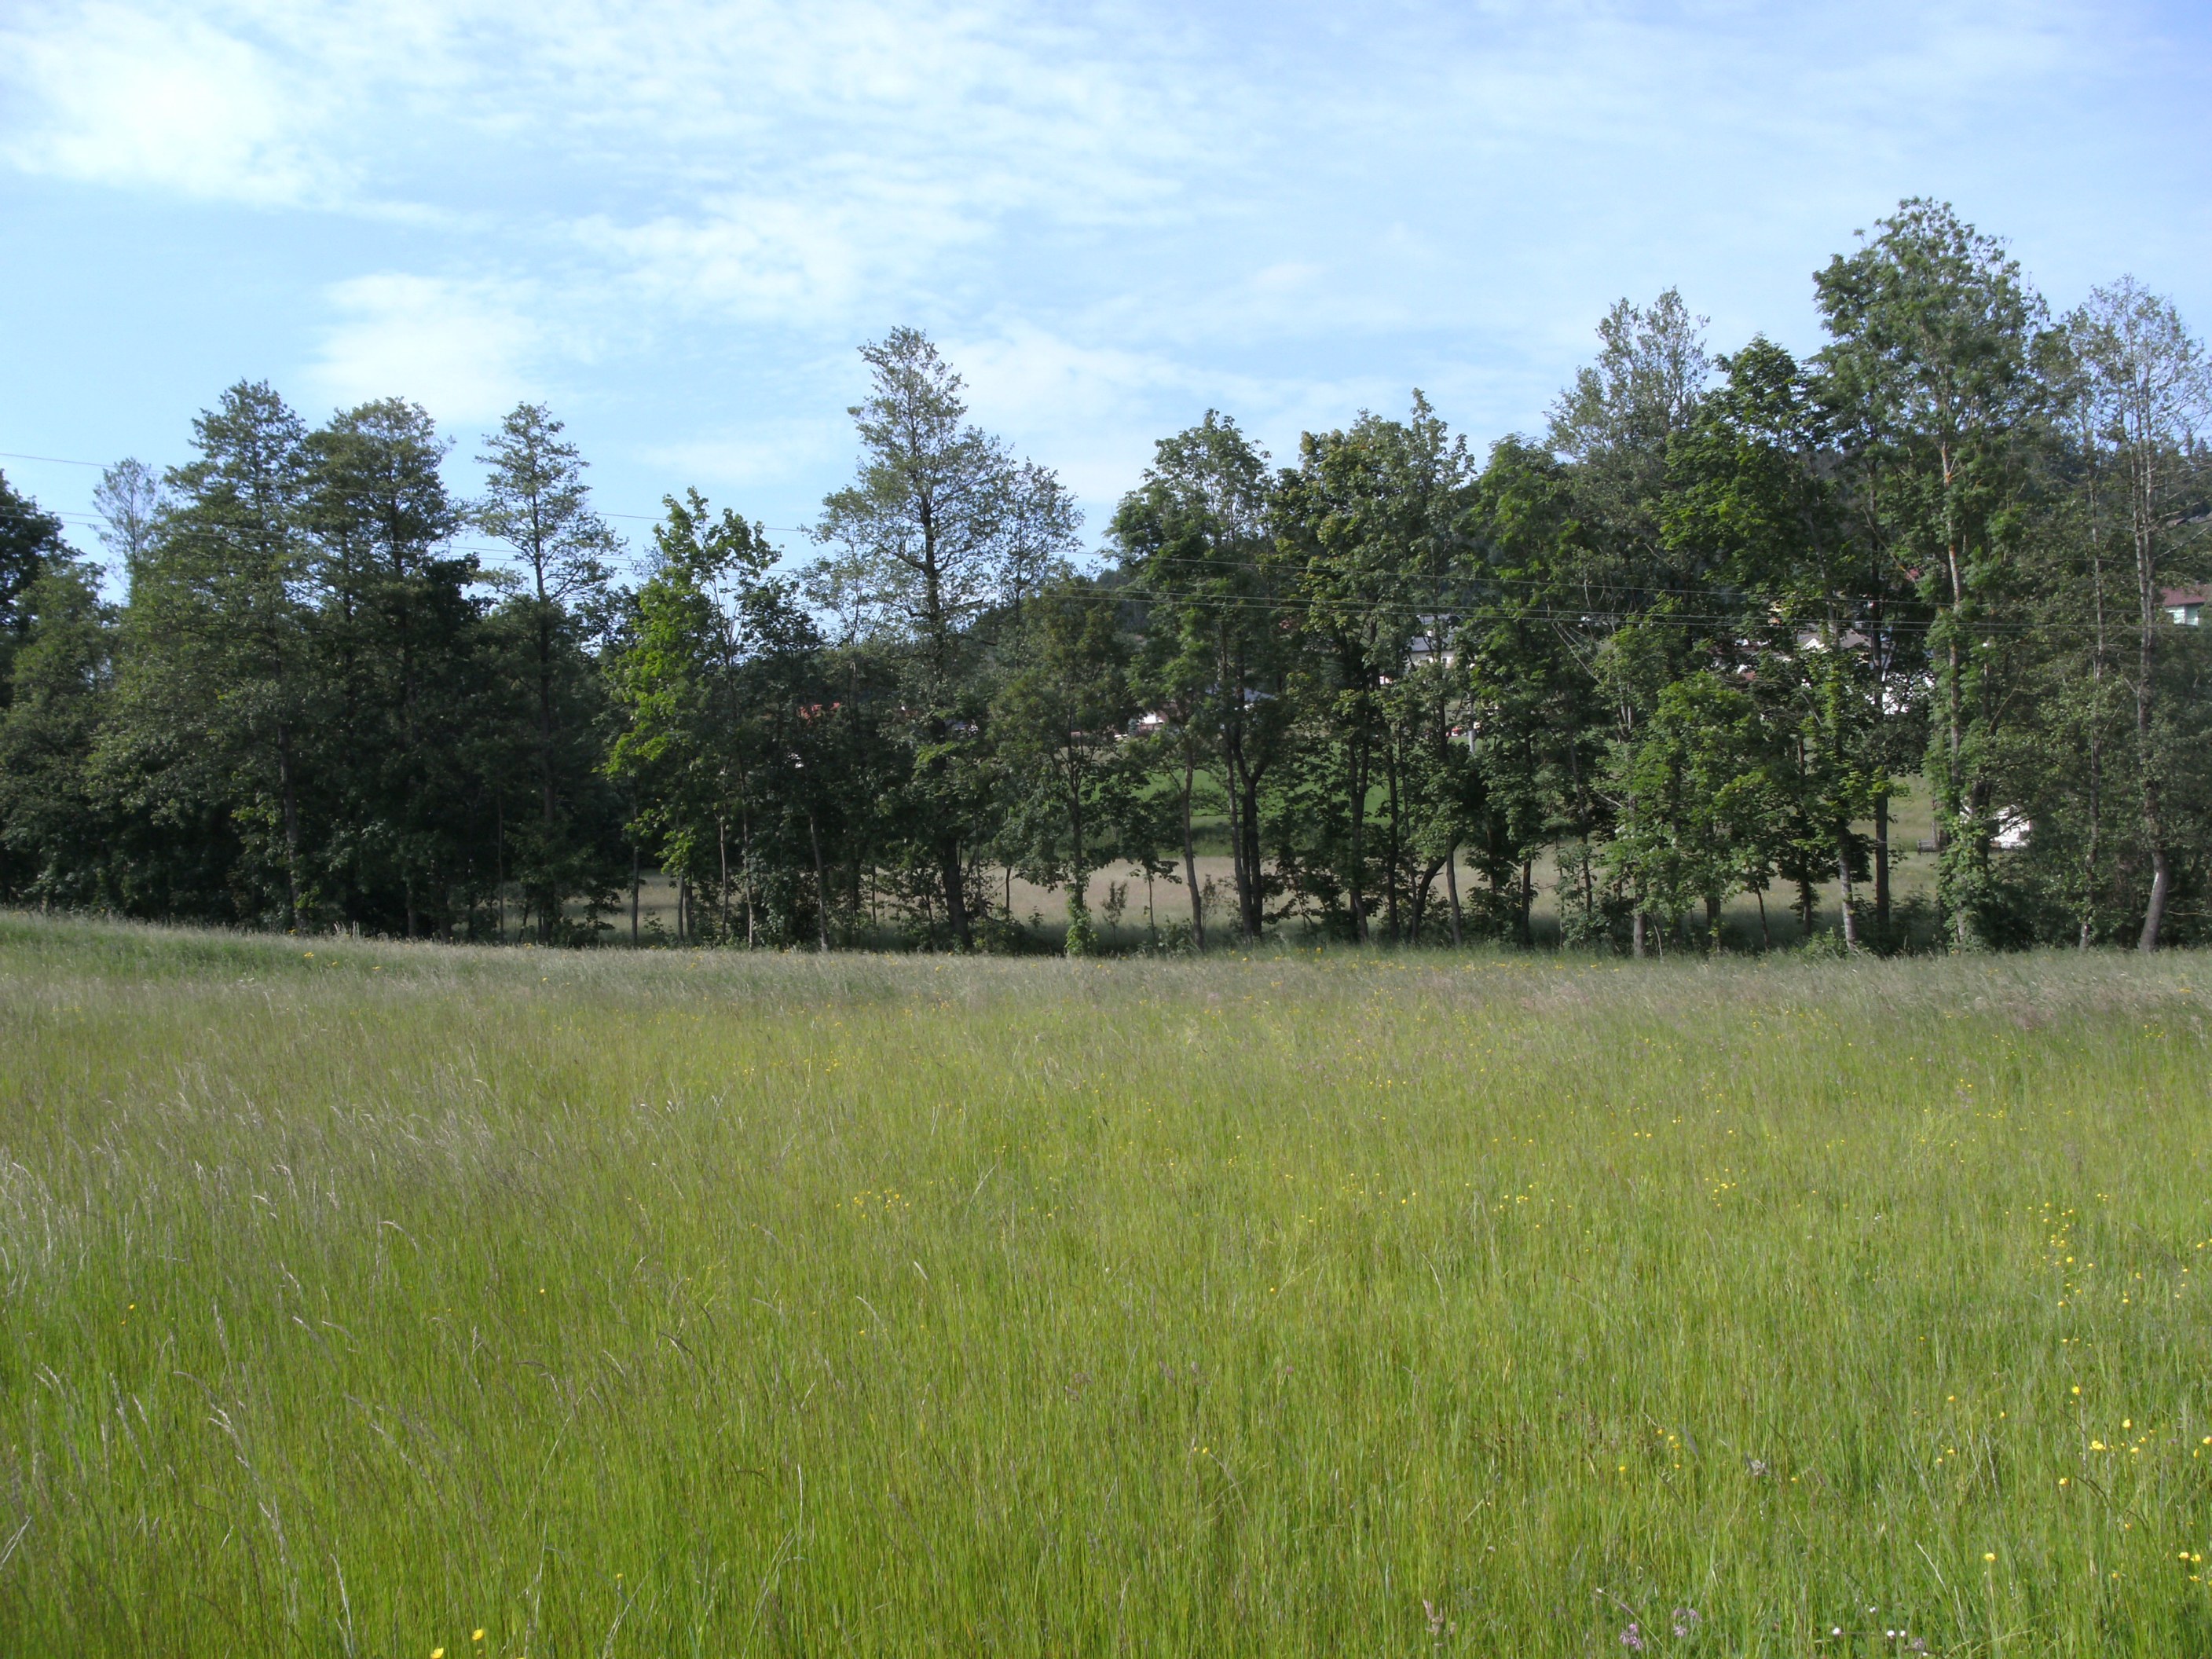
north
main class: Grassland
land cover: Grassland without tree/shrub cover
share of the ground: > 75 %
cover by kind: herbaceous plants 100 %
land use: Agriculture (excluding fallow land and kitchen gardens)
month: June
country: AT
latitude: 48.0941
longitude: 13.5573
